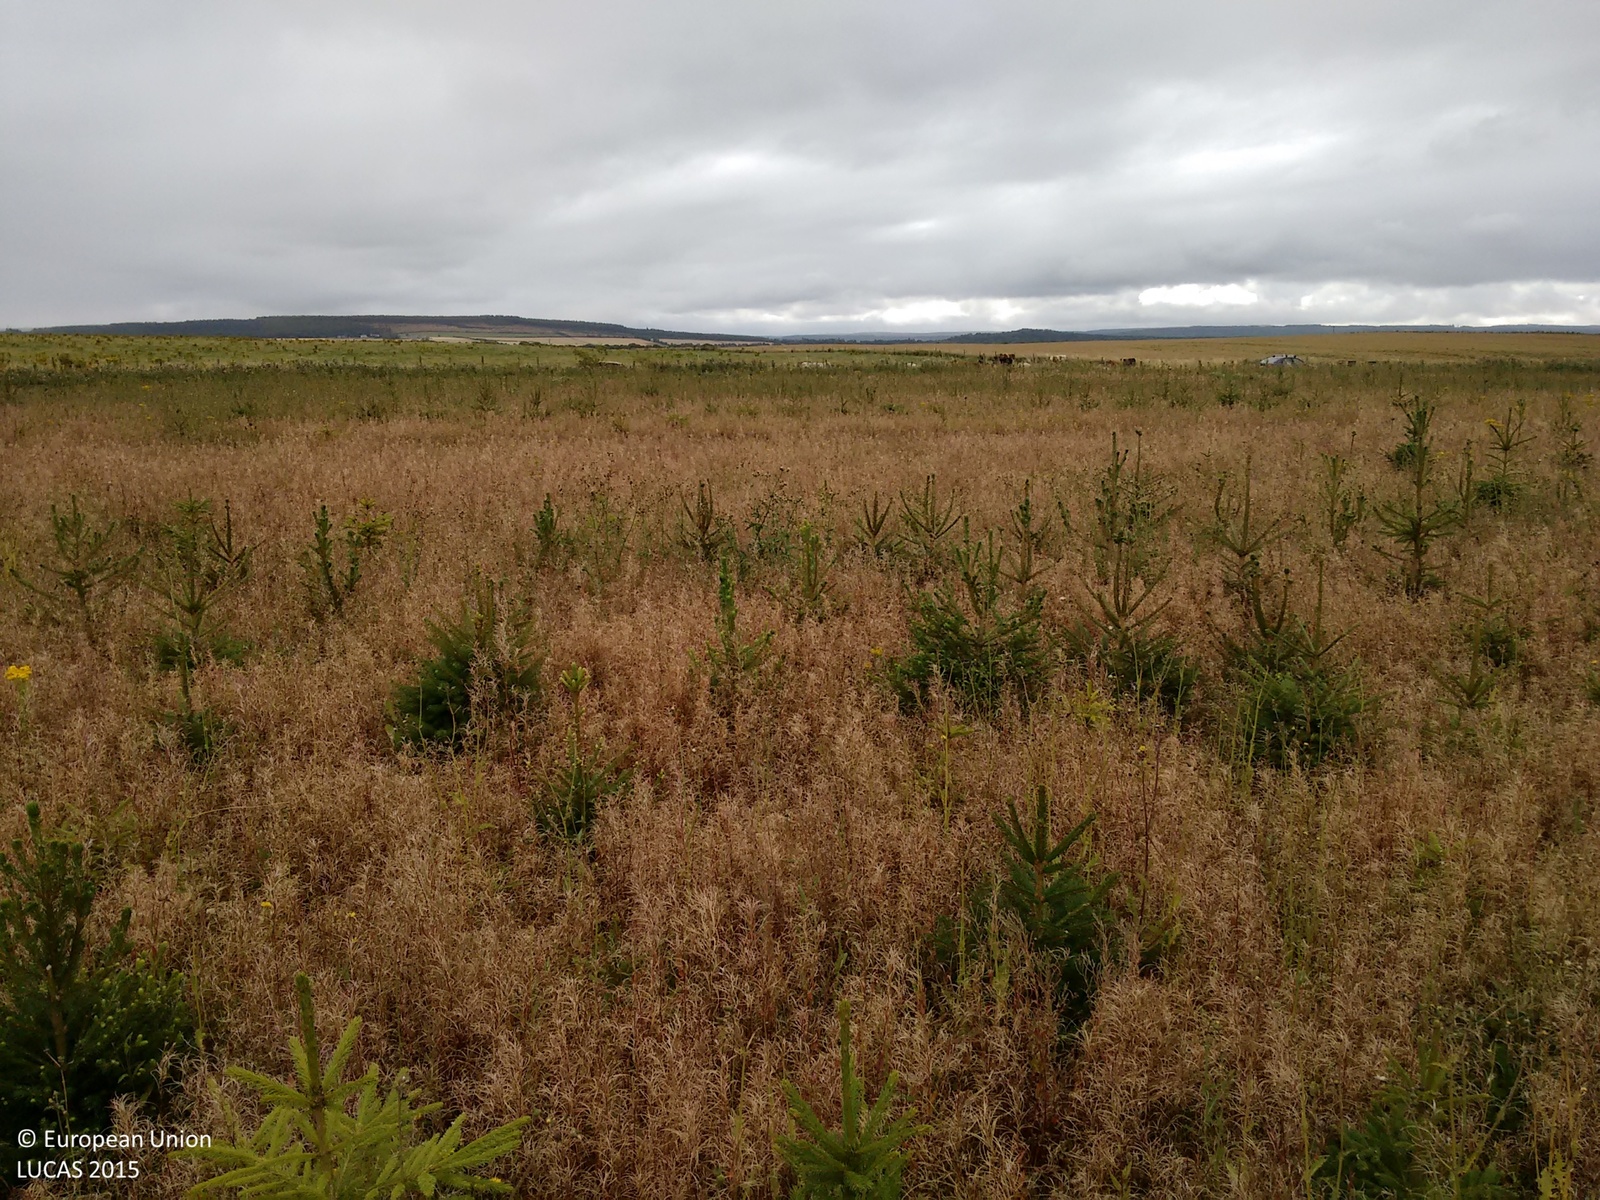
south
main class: Woodland
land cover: Spruce dominated coniferous woodland
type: exotic forest
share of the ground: < 10 %
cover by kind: herbaceous plants 90 %, coniferous forest trees 10 %
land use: Forestry
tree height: < 5 m
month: September
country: GB
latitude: 57.6902
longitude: -3.4033
